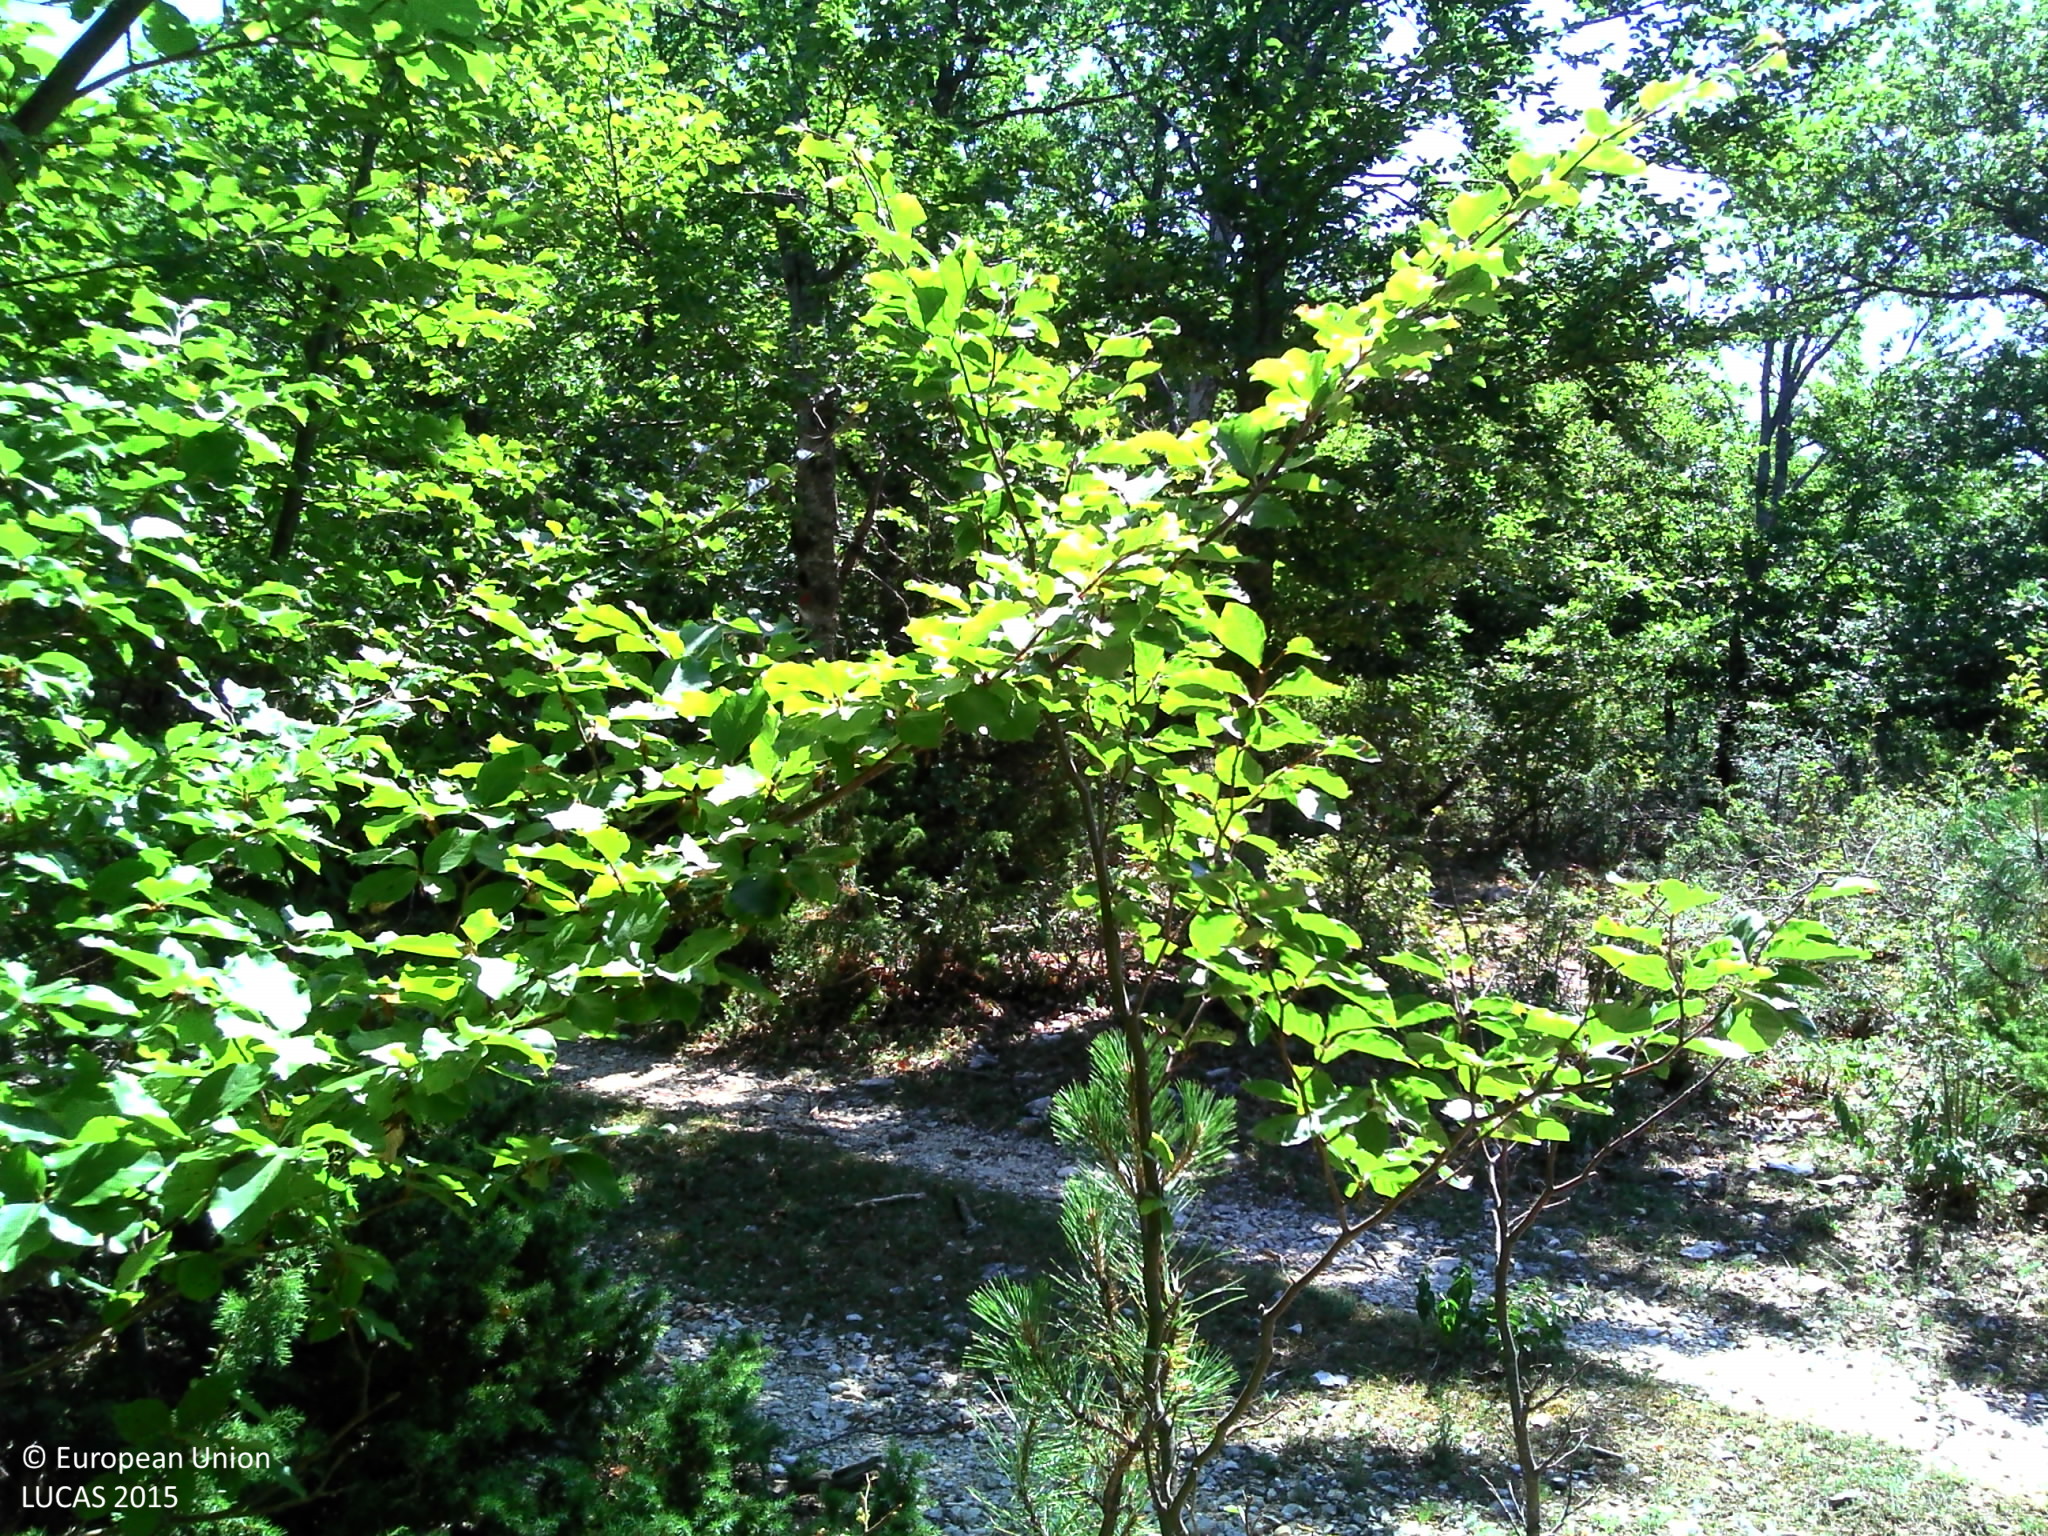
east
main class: Woodland
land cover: Broadleaved woodland
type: broadleaved evergreen forest
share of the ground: > 75 %
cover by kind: broadleaved forest trees 75 %, shrubs 20 %, herbaceous plants 5 %
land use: Semi-natural and natural areas not in use
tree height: > 5 m
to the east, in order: Broadleaved woodland; Tracks; Broadleaved woodland; Tracks; Broadleaved woodland; Pine dominated coniferous woodland
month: July
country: FR
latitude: 44.1355
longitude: 5.2957
